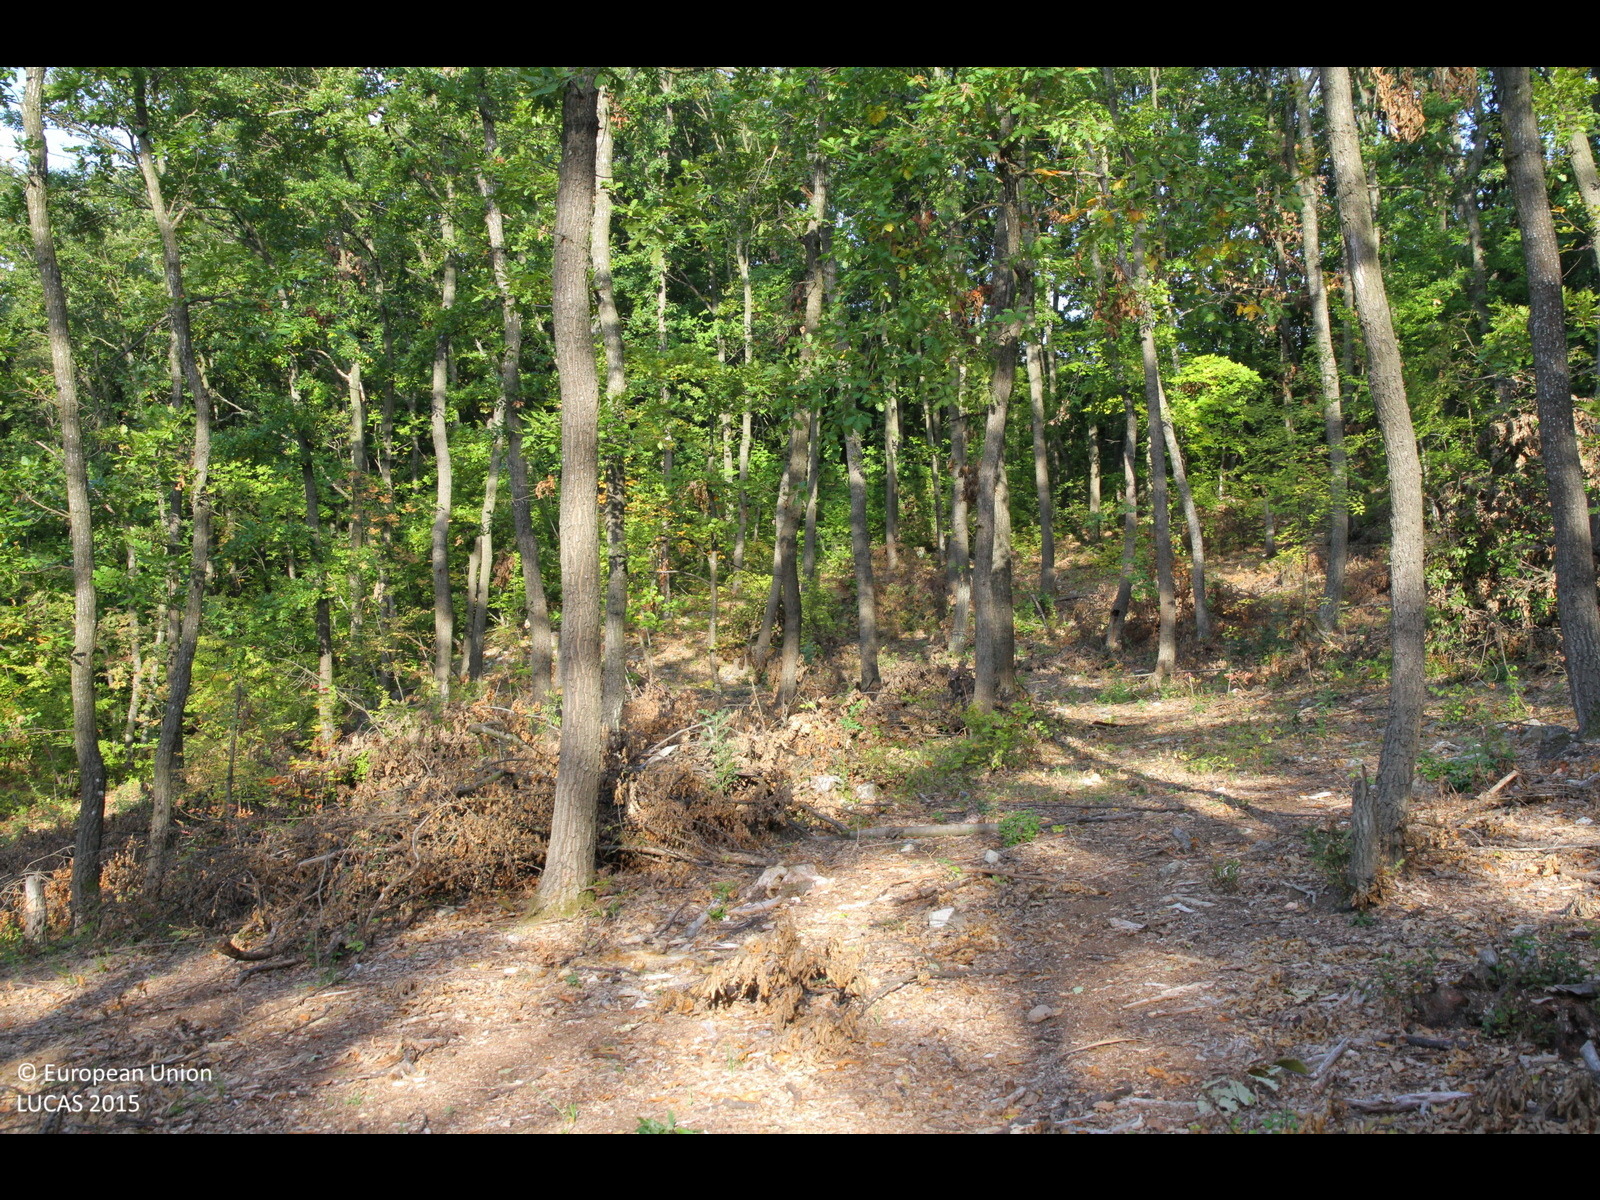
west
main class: Woodland
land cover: Broadleaved woodland
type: acidophilous oak and oak-birch forest
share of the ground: 50 - 75 %
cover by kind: broadleaved forest trees 70 %, unconsolidated bare surface 15 %, herbaceous plants 10 %, shrubs 5 %
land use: Forestry
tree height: > 5 m
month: October
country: BG
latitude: 43.3730
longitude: 27.2401
